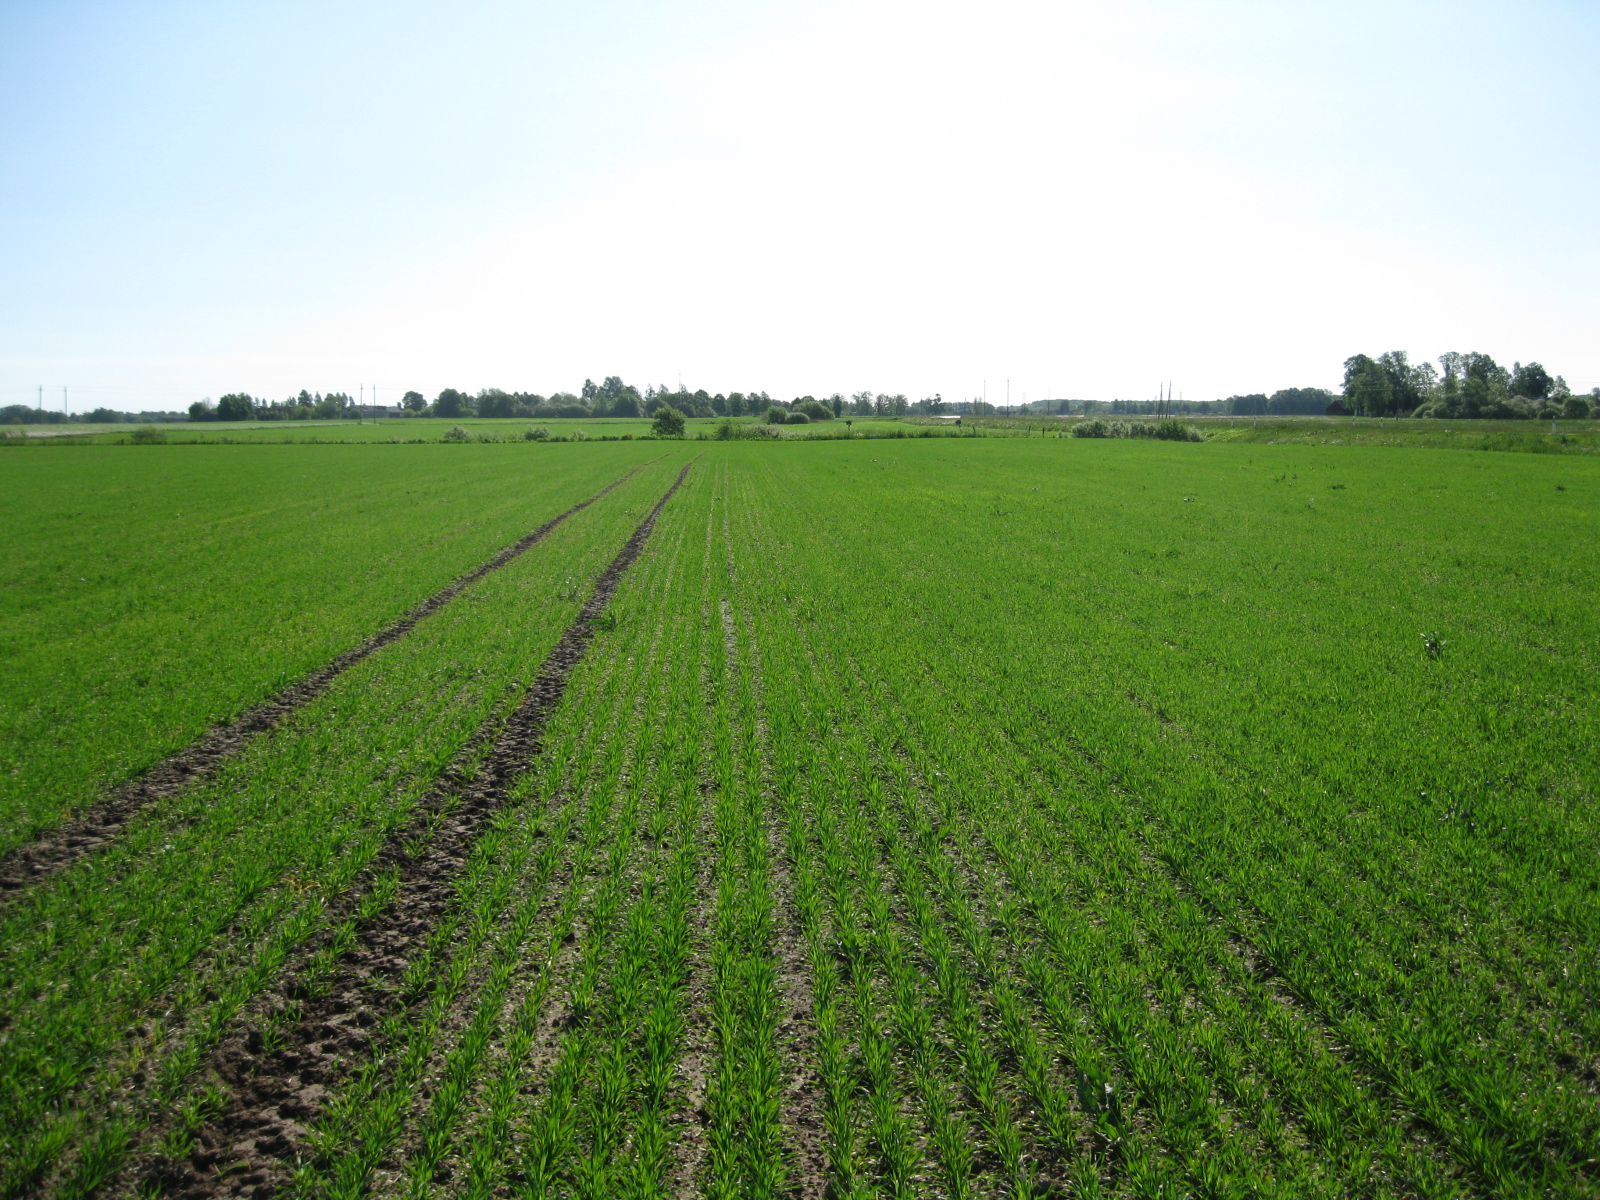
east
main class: Cropland
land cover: Barley
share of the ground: 50 - 75 %
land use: Agriculture (excluding fallow land and kitchen gardens)
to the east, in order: Barley; Spontaneously vegetated surfaces; Abandoned hedges; Ditches and canals; Grassland with sparse tree/shrub cover; Oats
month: May
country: LT
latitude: 55.8869
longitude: 24.8312
